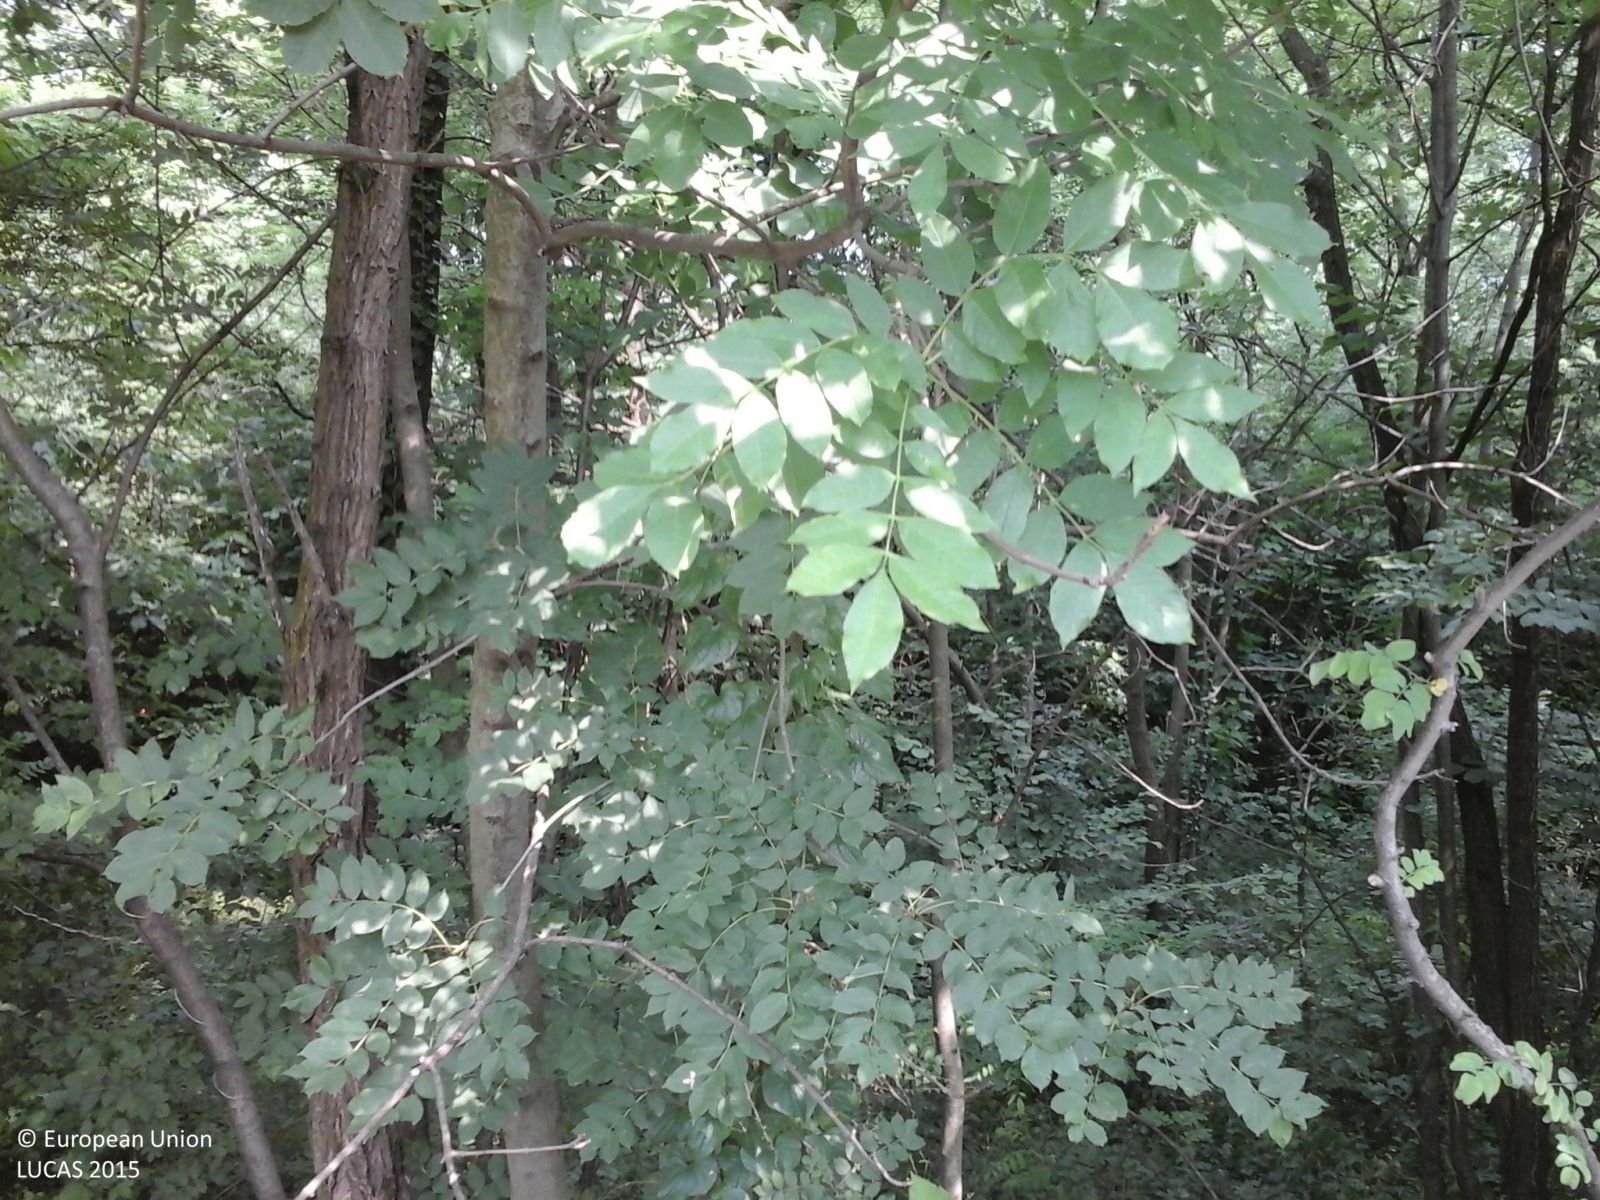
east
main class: Woodland
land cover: Broadleaved woodland
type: thermophilous deciduous forest
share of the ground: > 75 %
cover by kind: broadleaved forest trees 100 %
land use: Semi-natural and natural areas not in use
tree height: > 5 m
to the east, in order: Broadleaved woodland
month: May
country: IT
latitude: 45.3896
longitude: 7.7173
